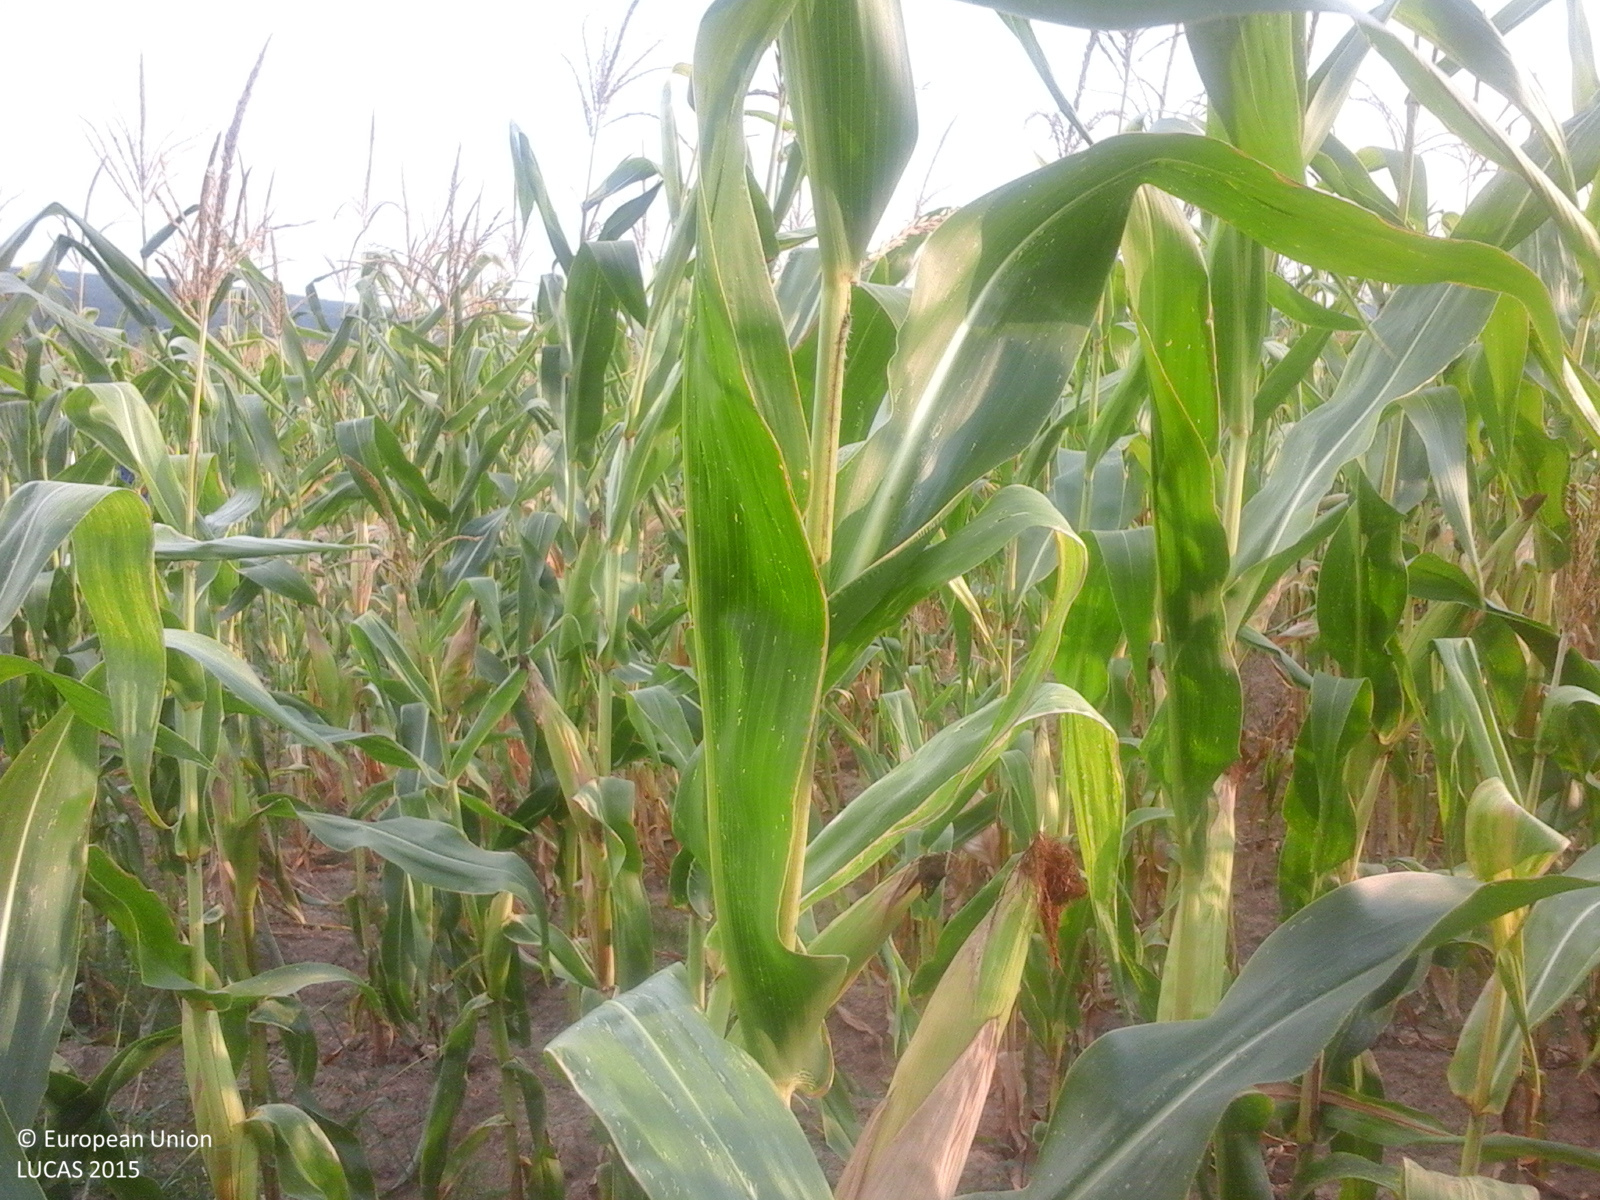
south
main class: Cropland
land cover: Maize
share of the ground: > 75 %
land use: Agriculture (excluding fallow land and kitchen gardens)
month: August
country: RO
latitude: 44.7606
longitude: 23.6386
